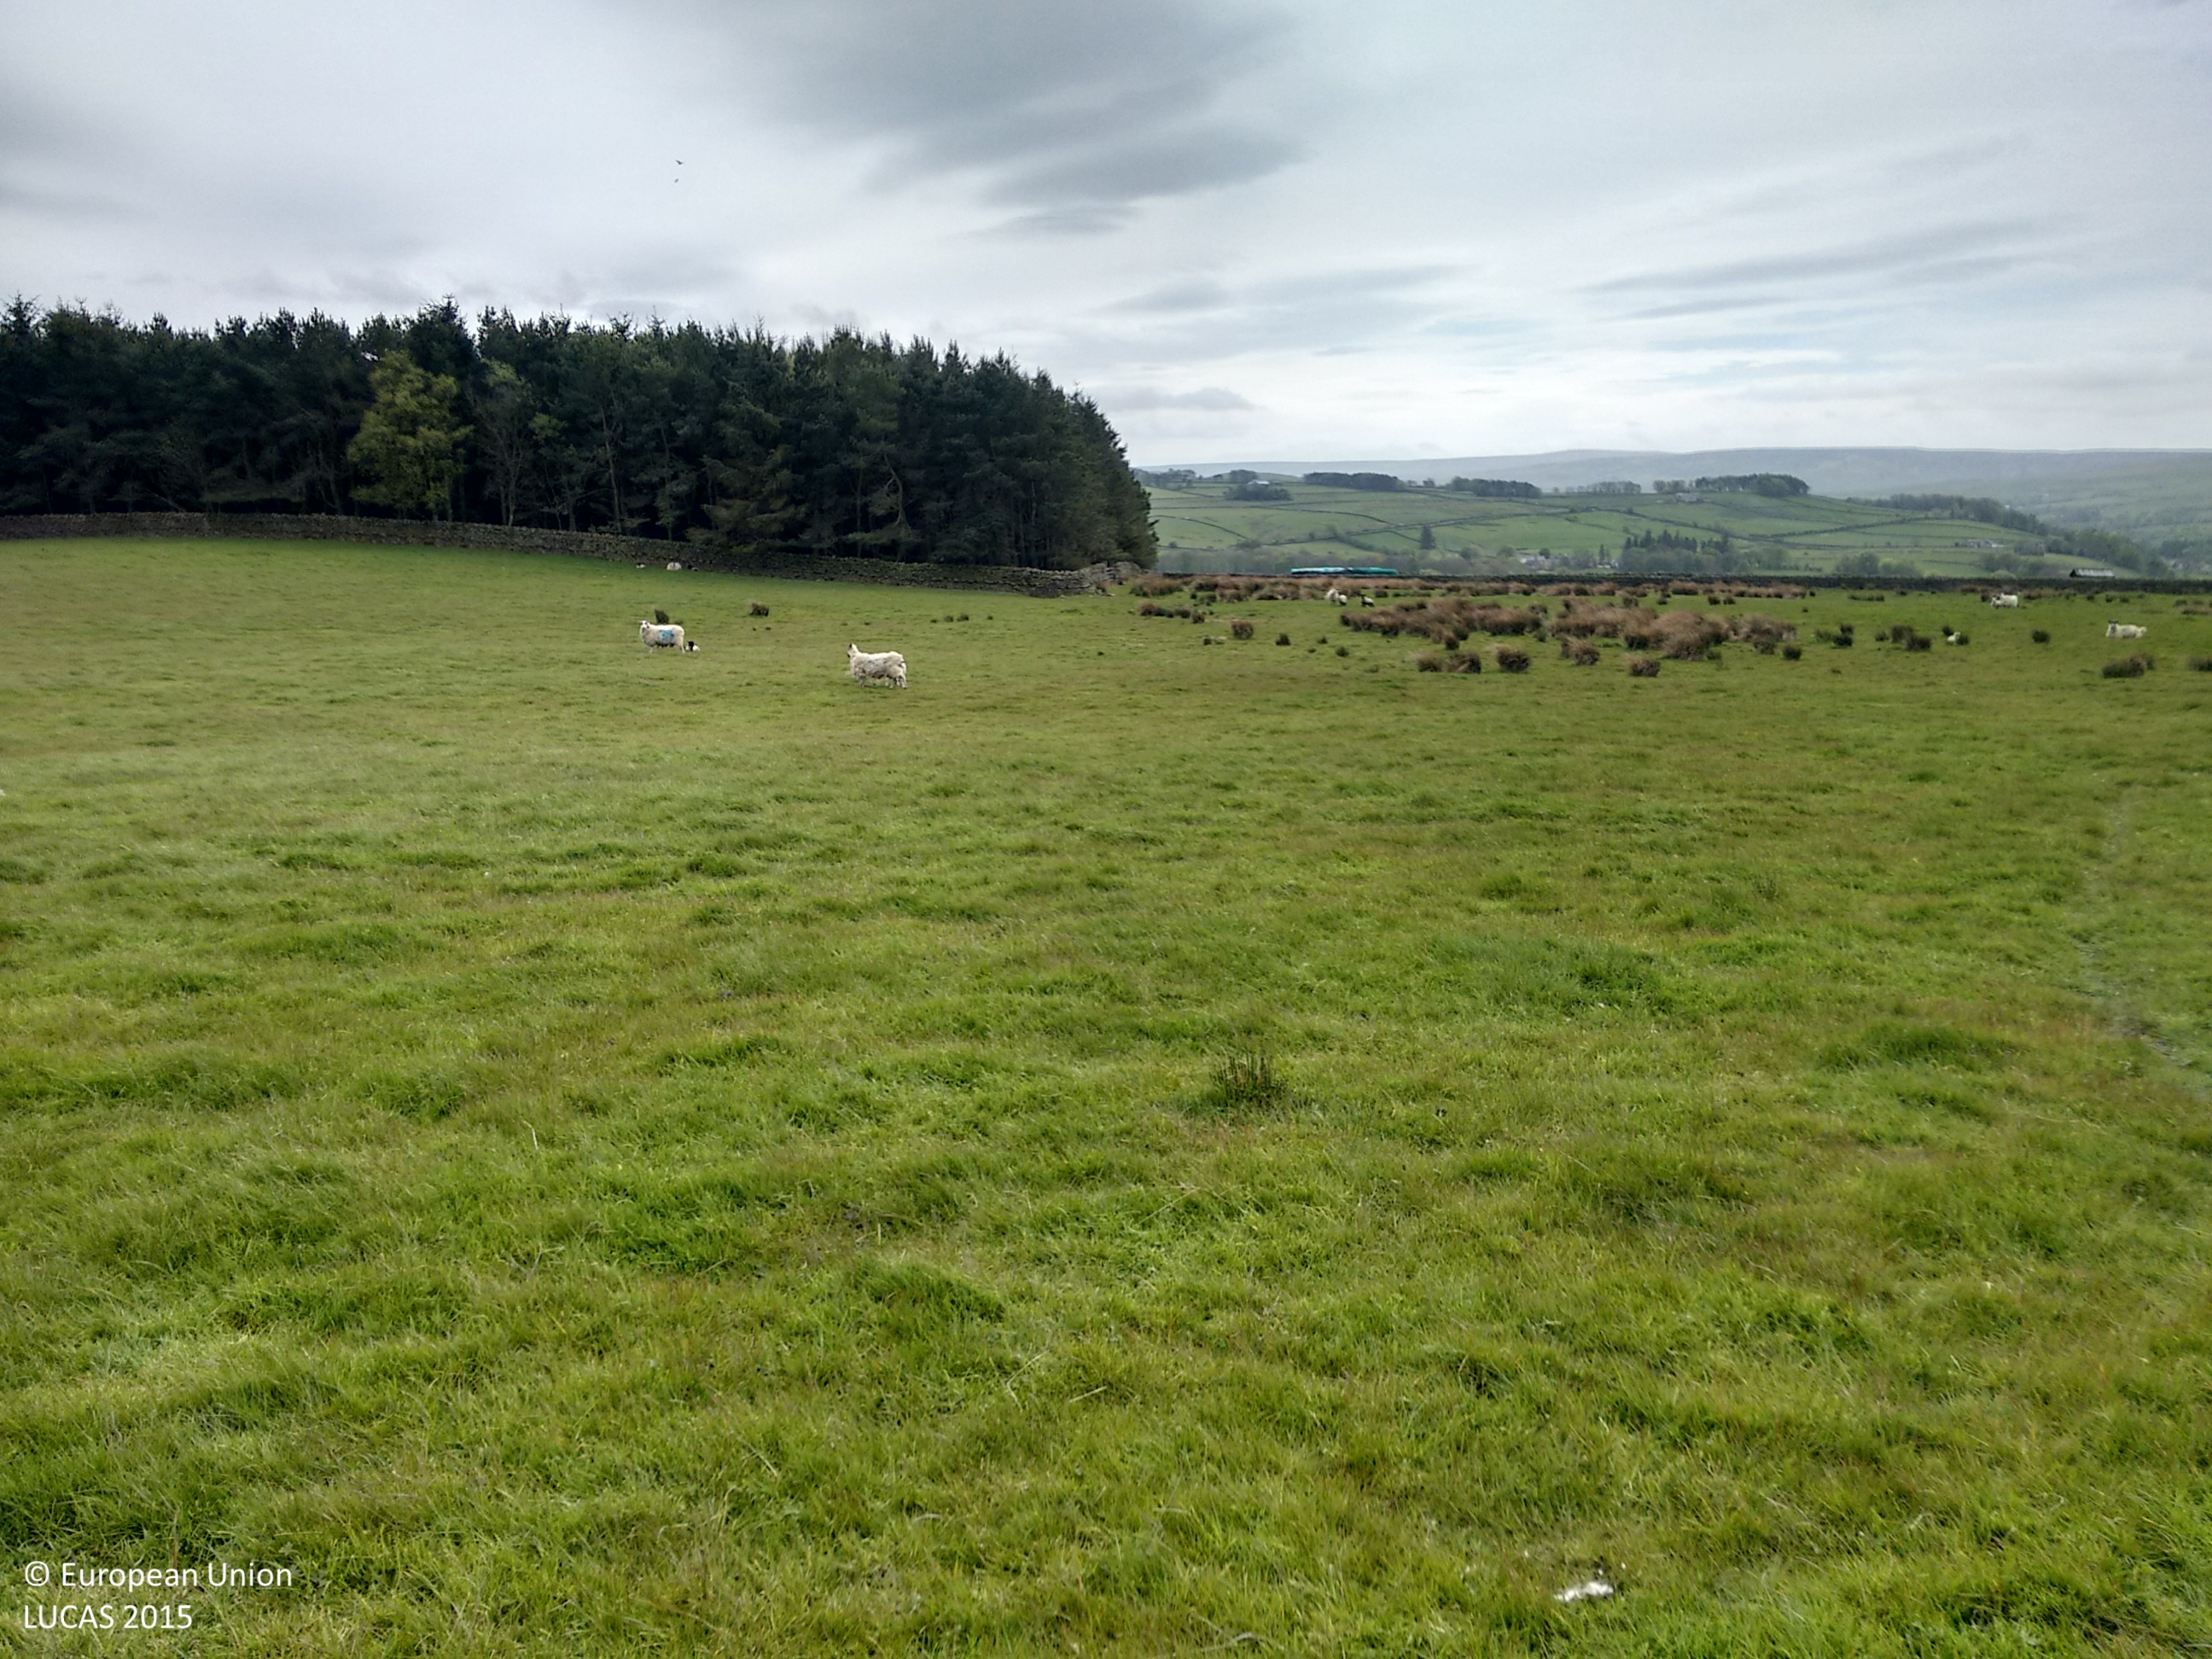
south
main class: Grassland
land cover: Grassland without tree/shrub cover
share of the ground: > 75 %
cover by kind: herbaceous plants 100 %
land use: Agriculture (excluding fallow land and kitchen gardens)
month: May
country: GB
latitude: 54.9073
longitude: -2.2398
